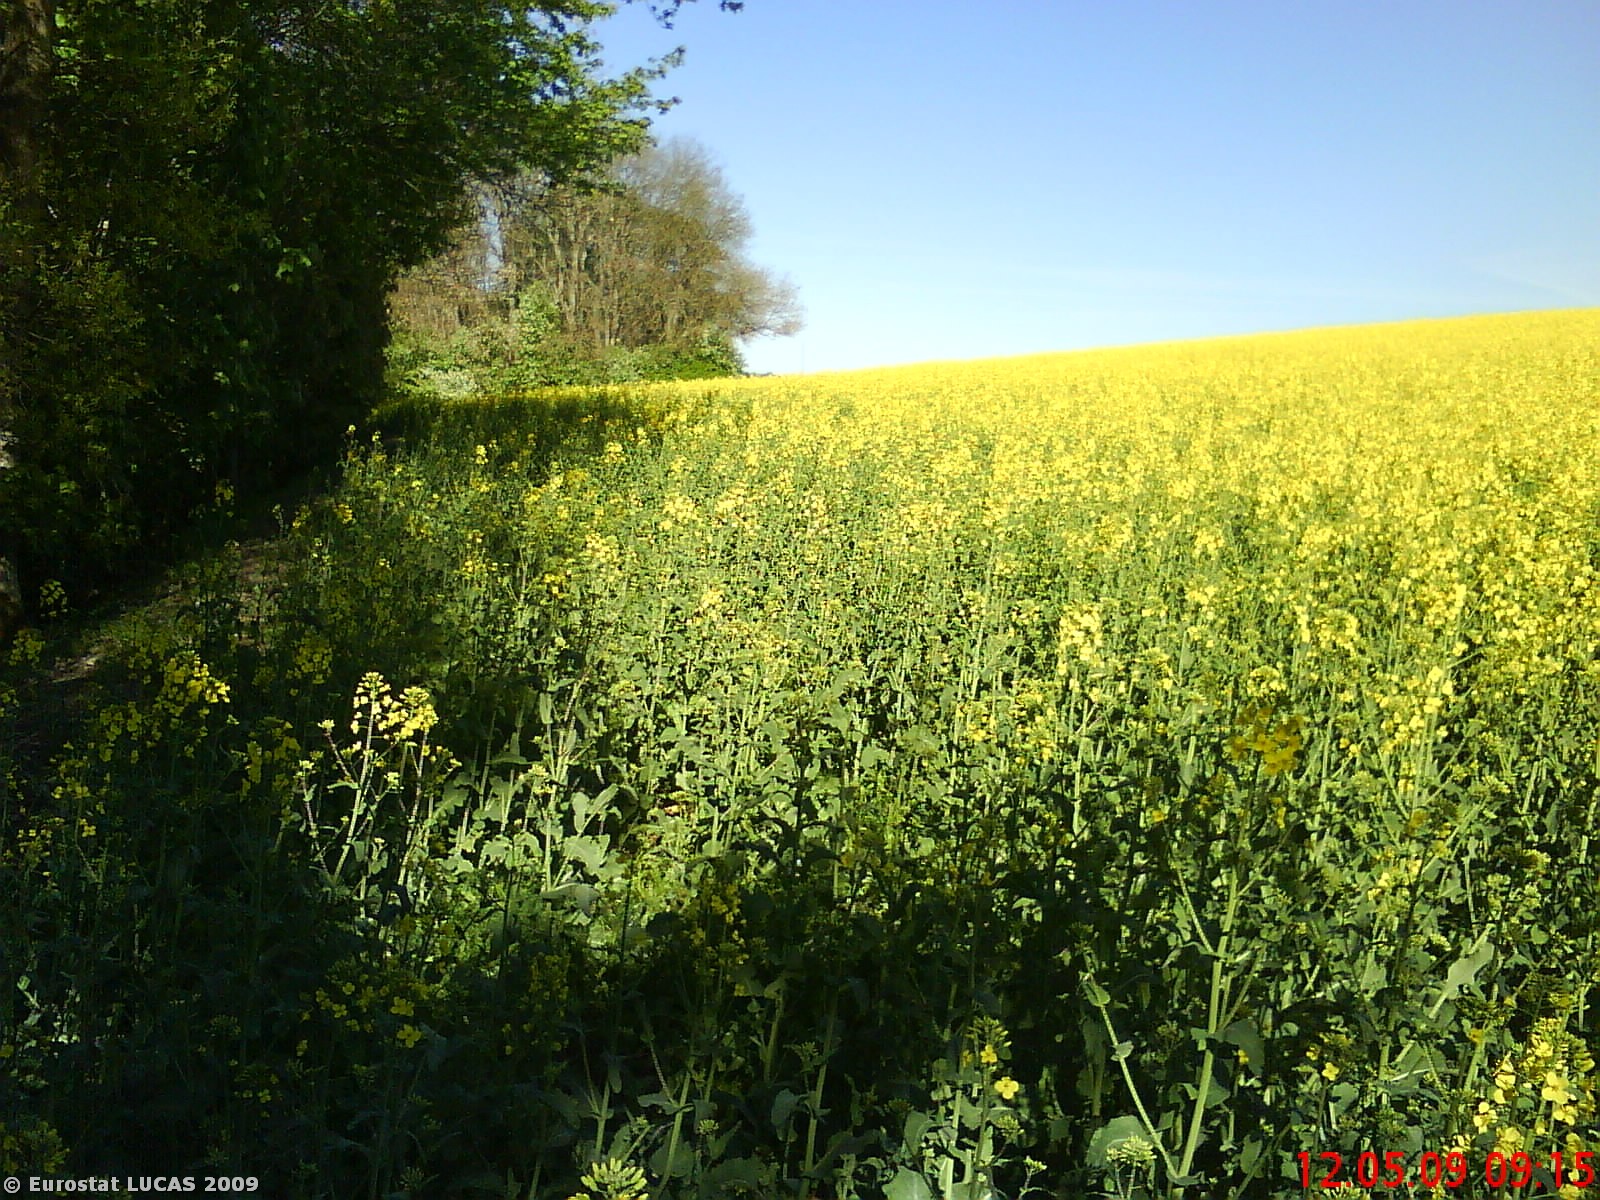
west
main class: Cropland
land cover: Rape and turnip rape
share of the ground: > 75 %
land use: Agriculture (excluding fallow land and kitchen gardens)
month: May
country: DK
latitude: 56.3291
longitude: 10.7915
